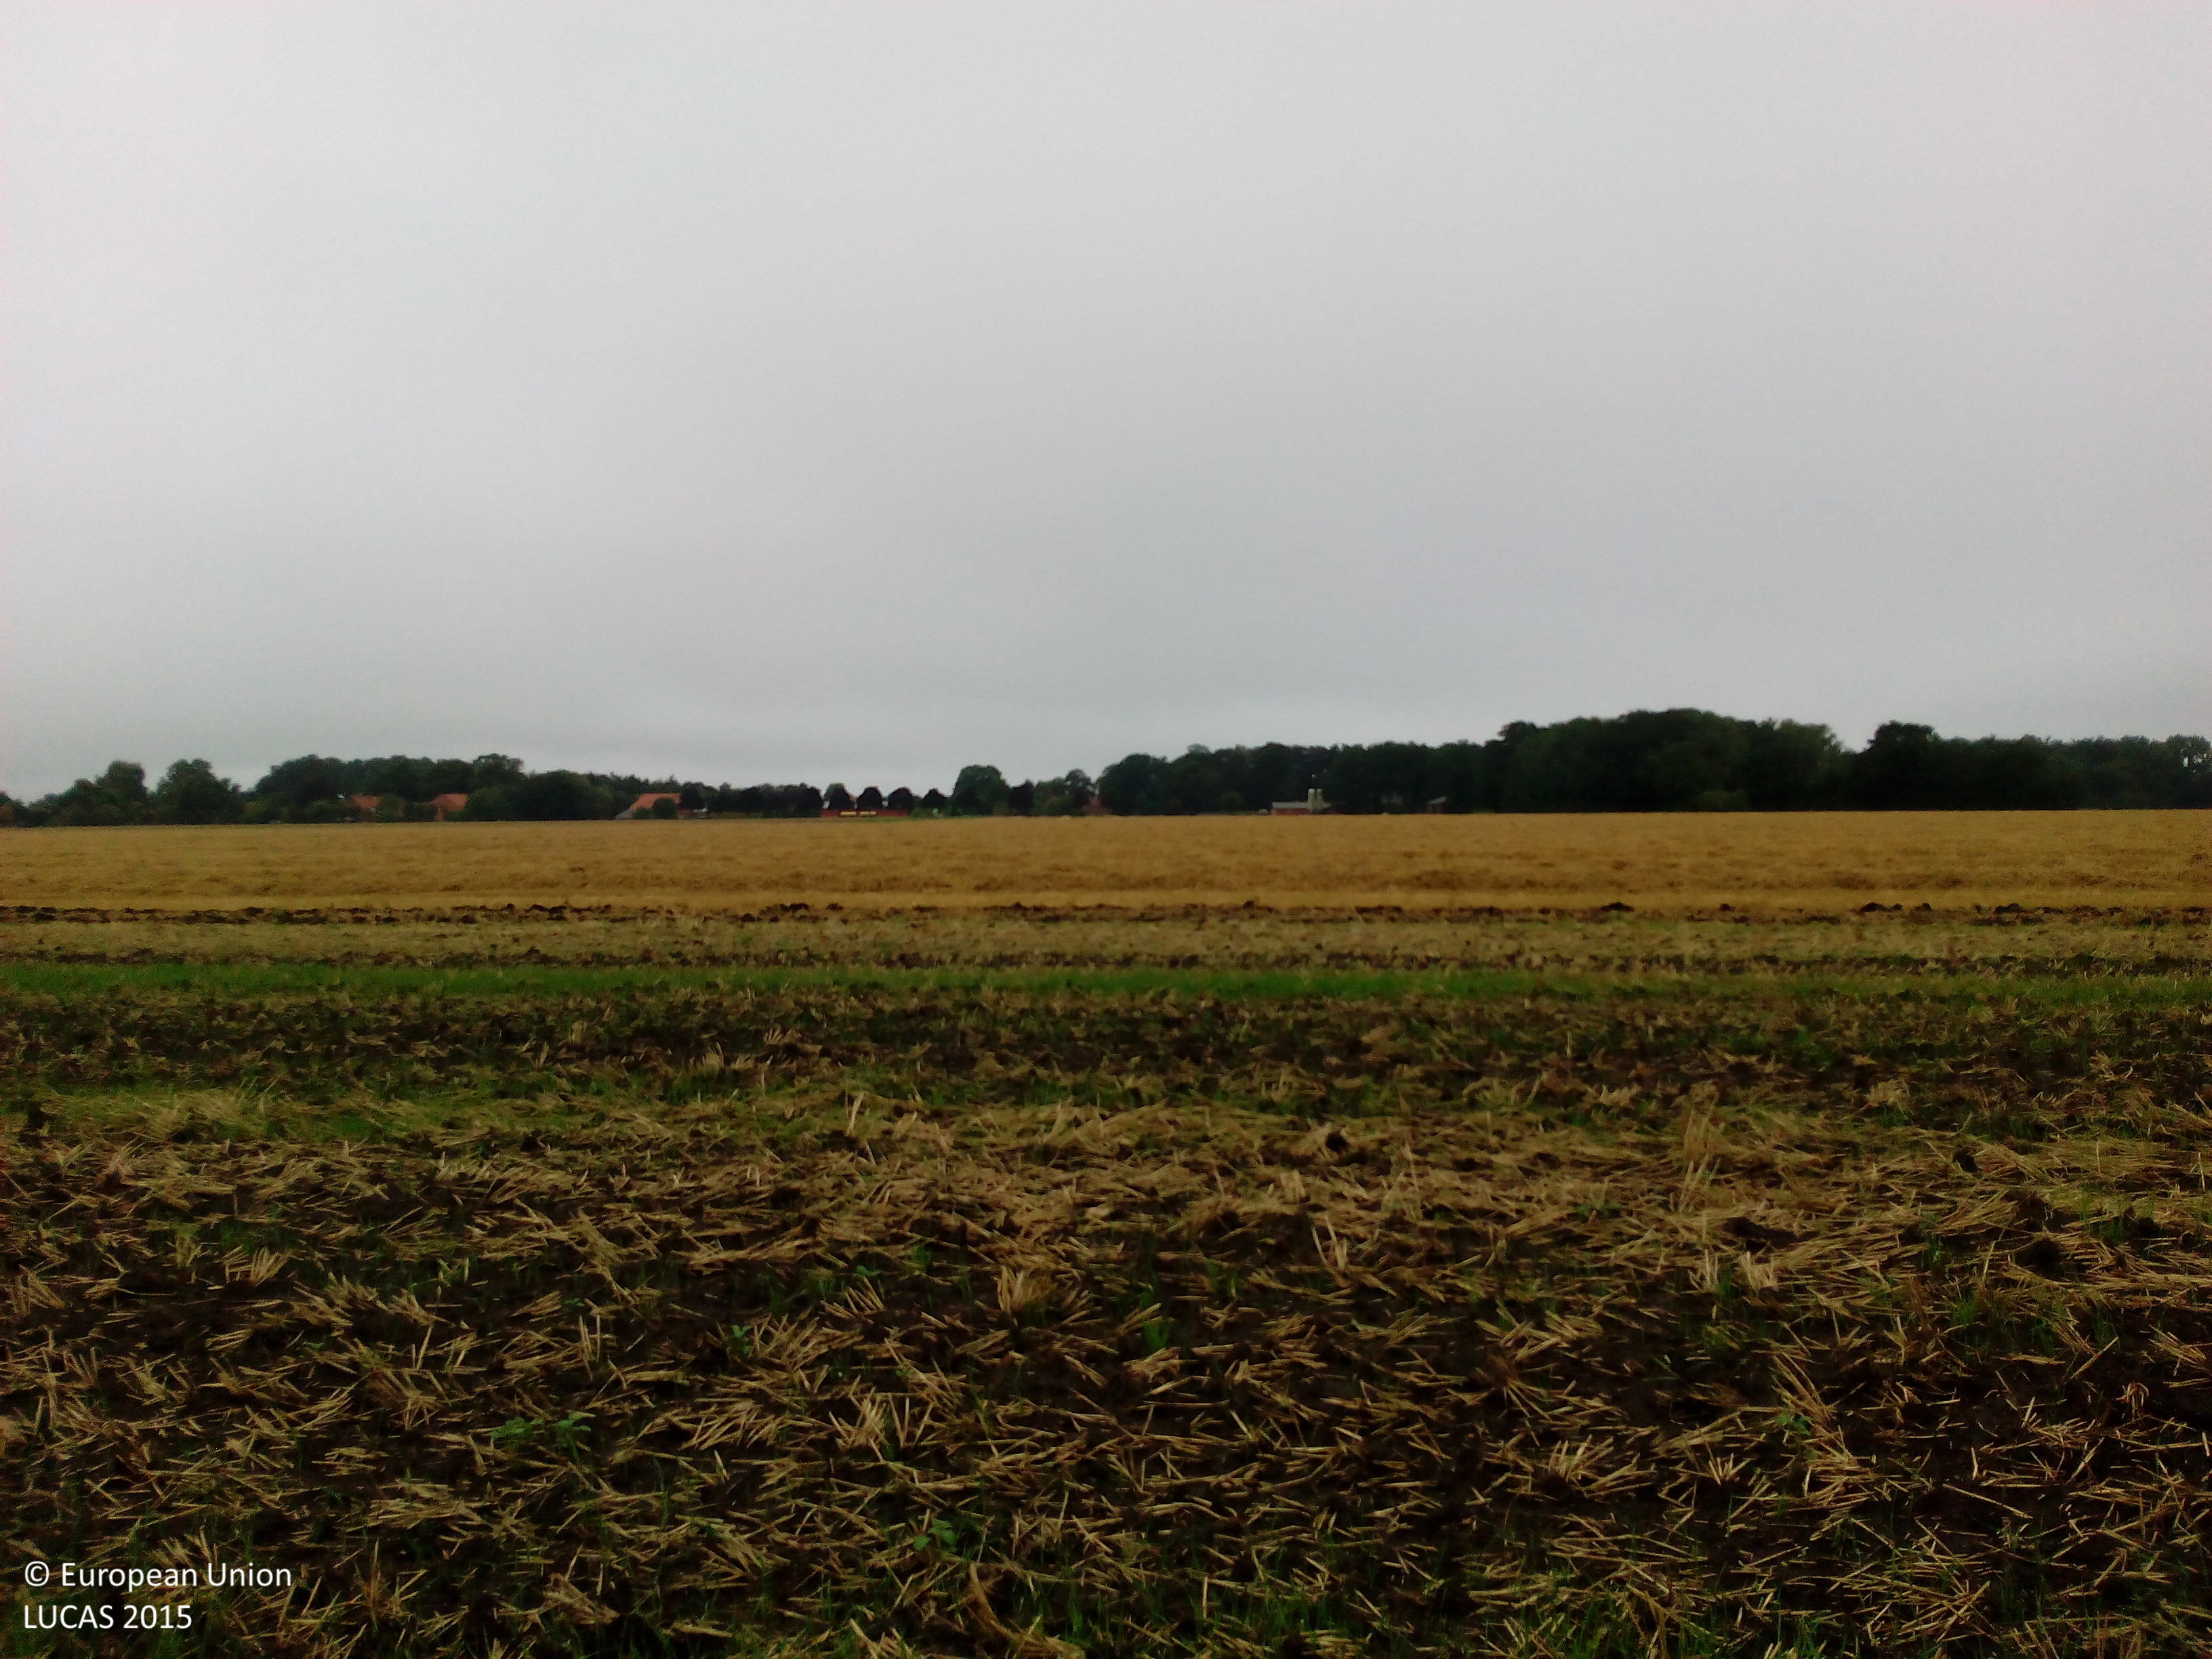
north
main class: Cropland
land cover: Common wheat
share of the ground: 25 - 50 %
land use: Agriculture (excluding fallow land and kitchen gardens)
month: August
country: DE
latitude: 52.8006
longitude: 8.5914
